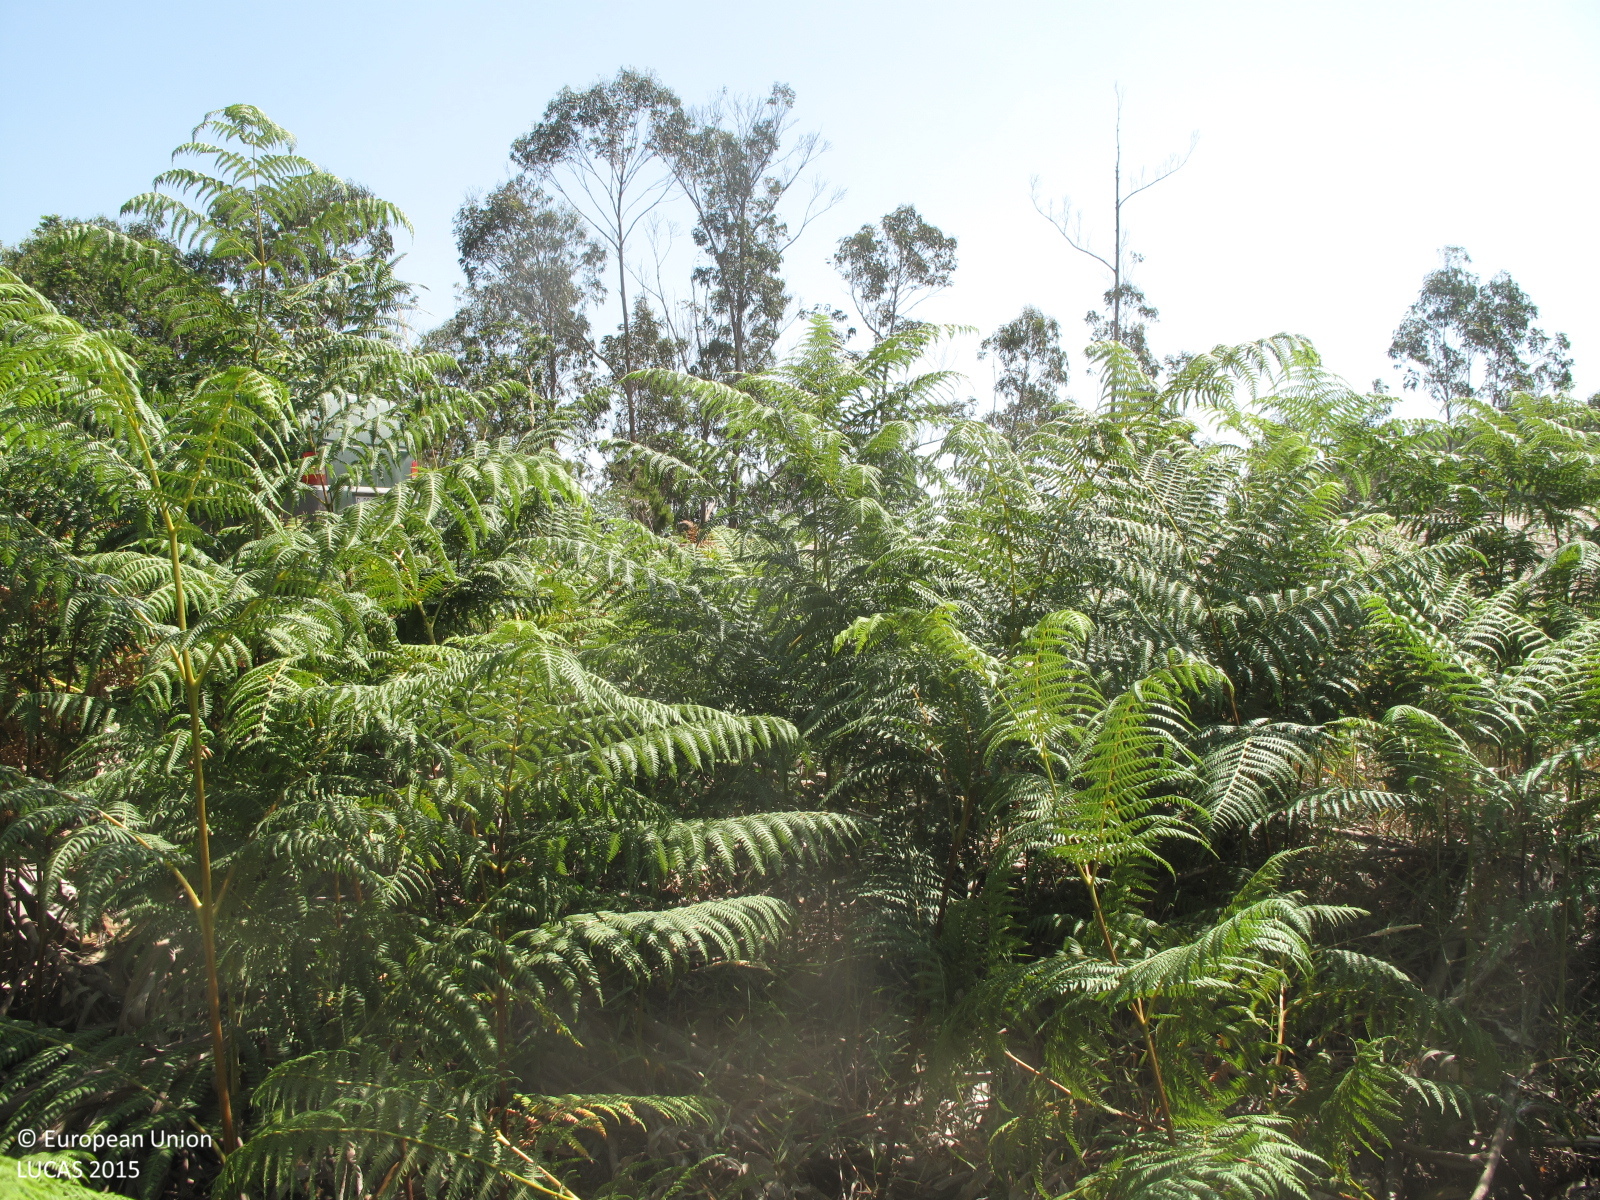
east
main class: Woodland
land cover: Broadleaved woodland
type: exotic forest
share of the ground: 25 - 50 %
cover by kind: shrubs 60 %, broadleaved forest trees 30 %, herbaceous plants 10 %
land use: Forestry
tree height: > 5 m
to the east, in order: Broadleaved woodland
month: July
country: ES
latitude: 43.4216
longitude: -8.1196
